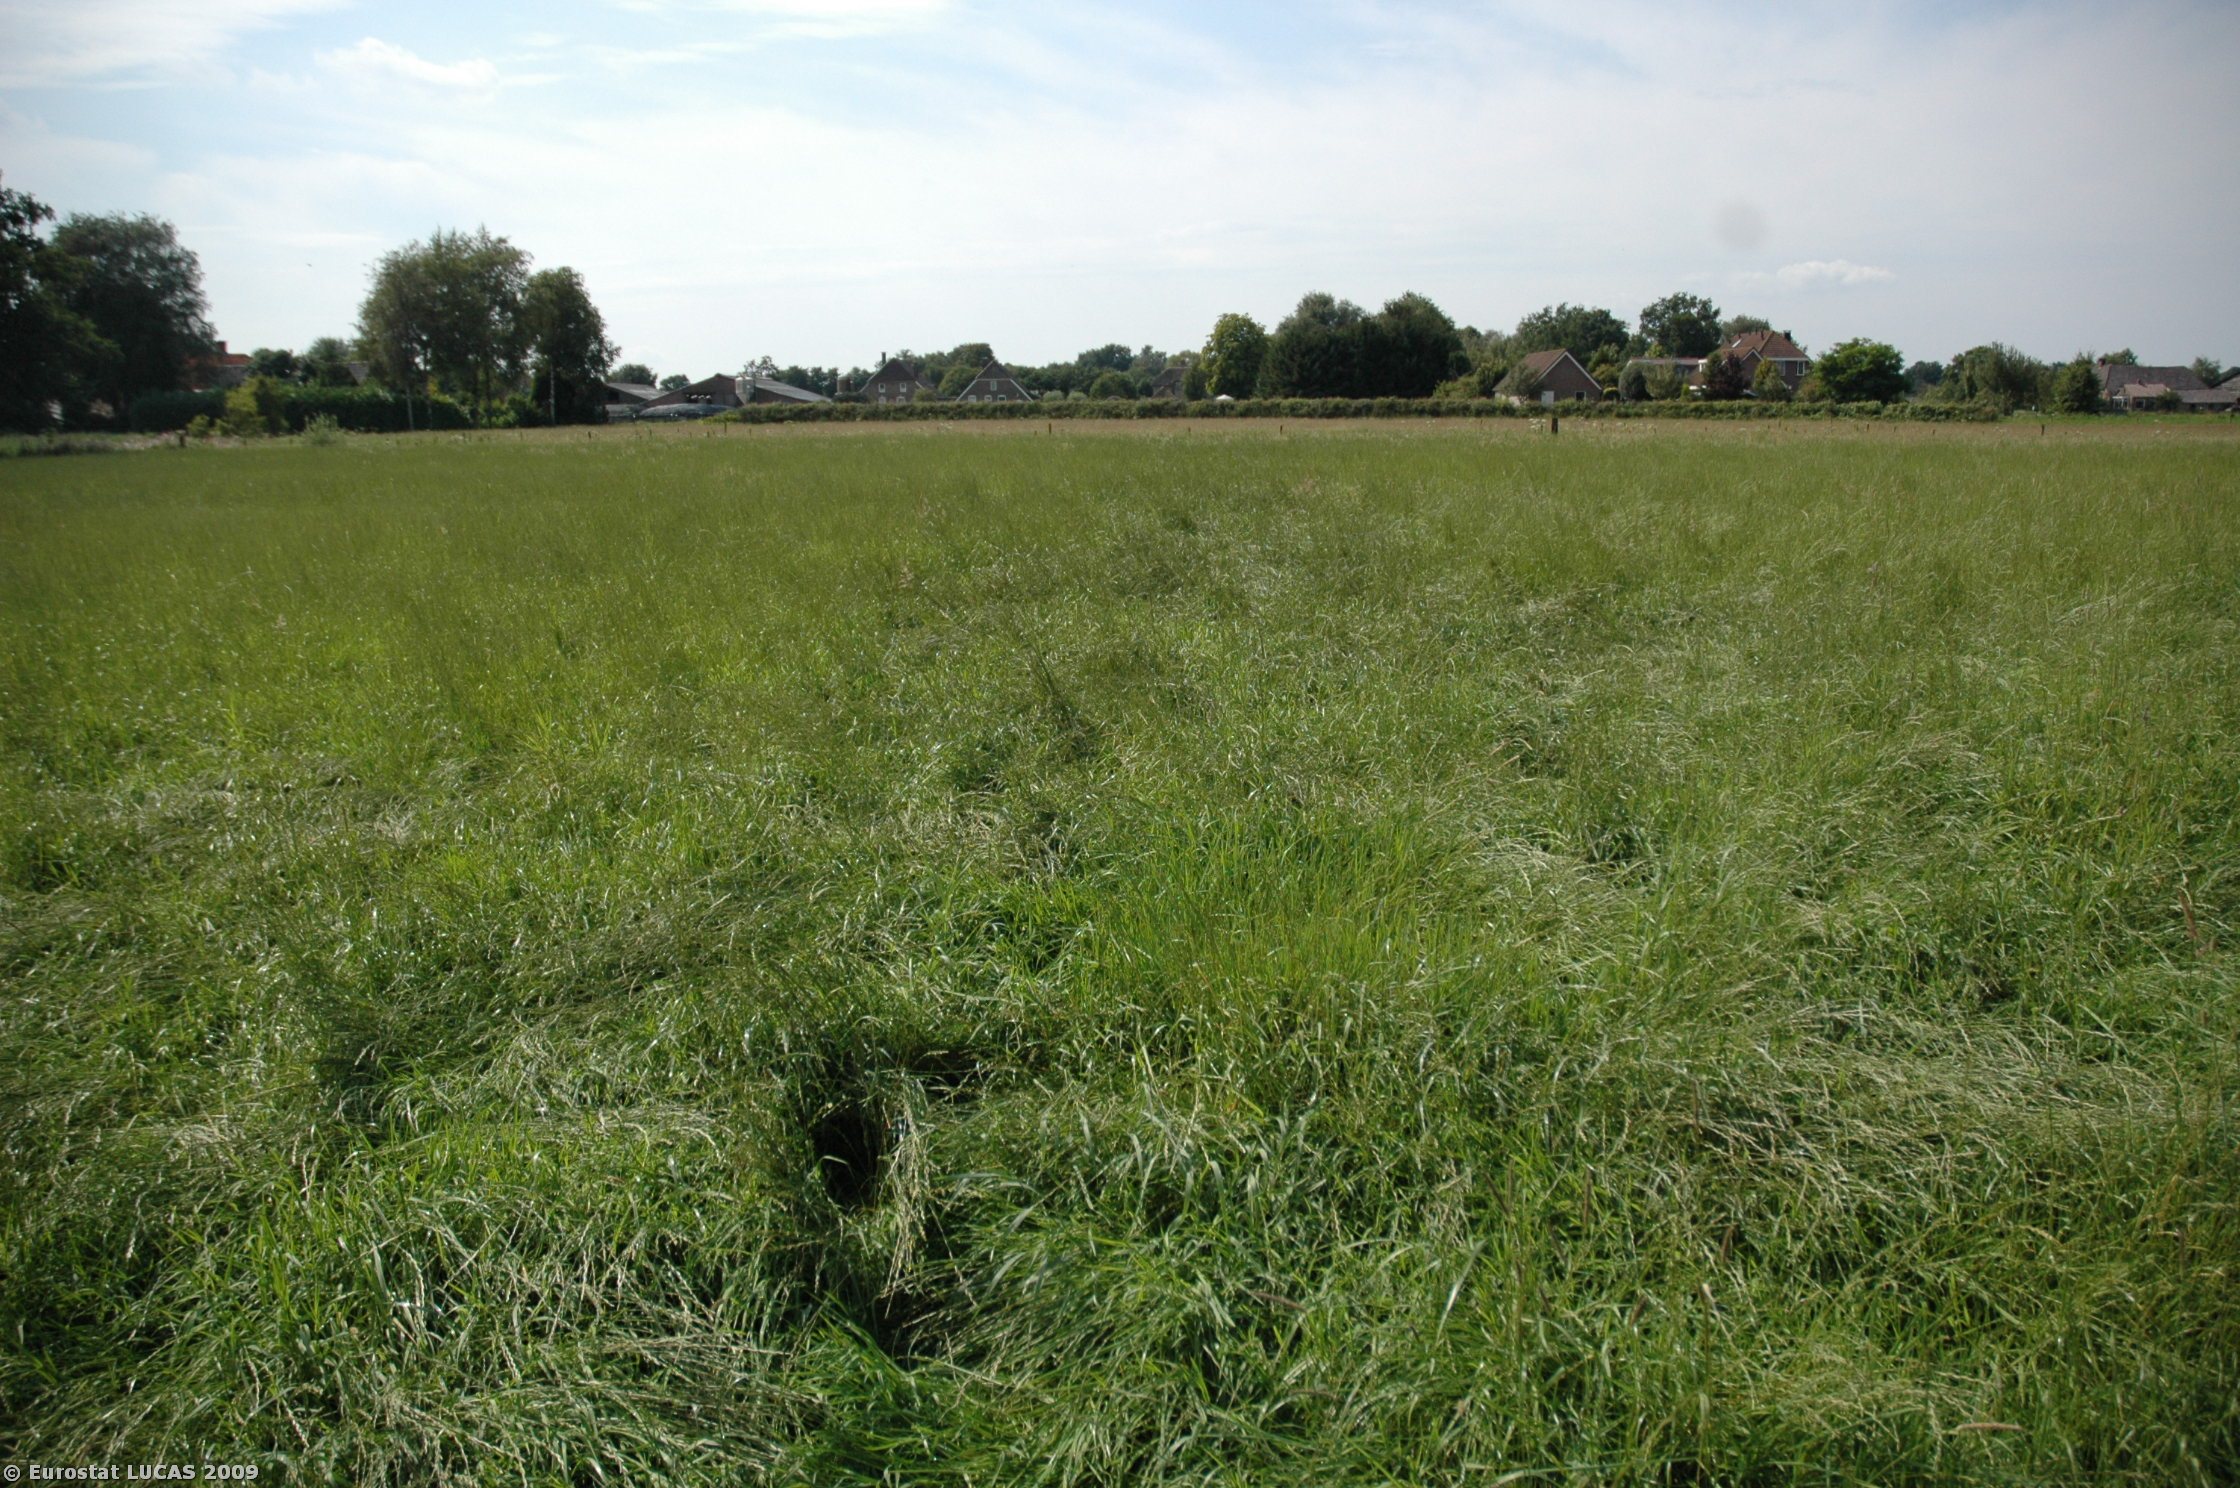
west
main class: Grassland
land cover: Grassland without tree/shrub cover
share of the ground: > 75 %
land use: Agriculture (excluding fallow land and kitchen gardens)
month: August
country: NL
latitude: 52.4026
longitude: 6.0749
